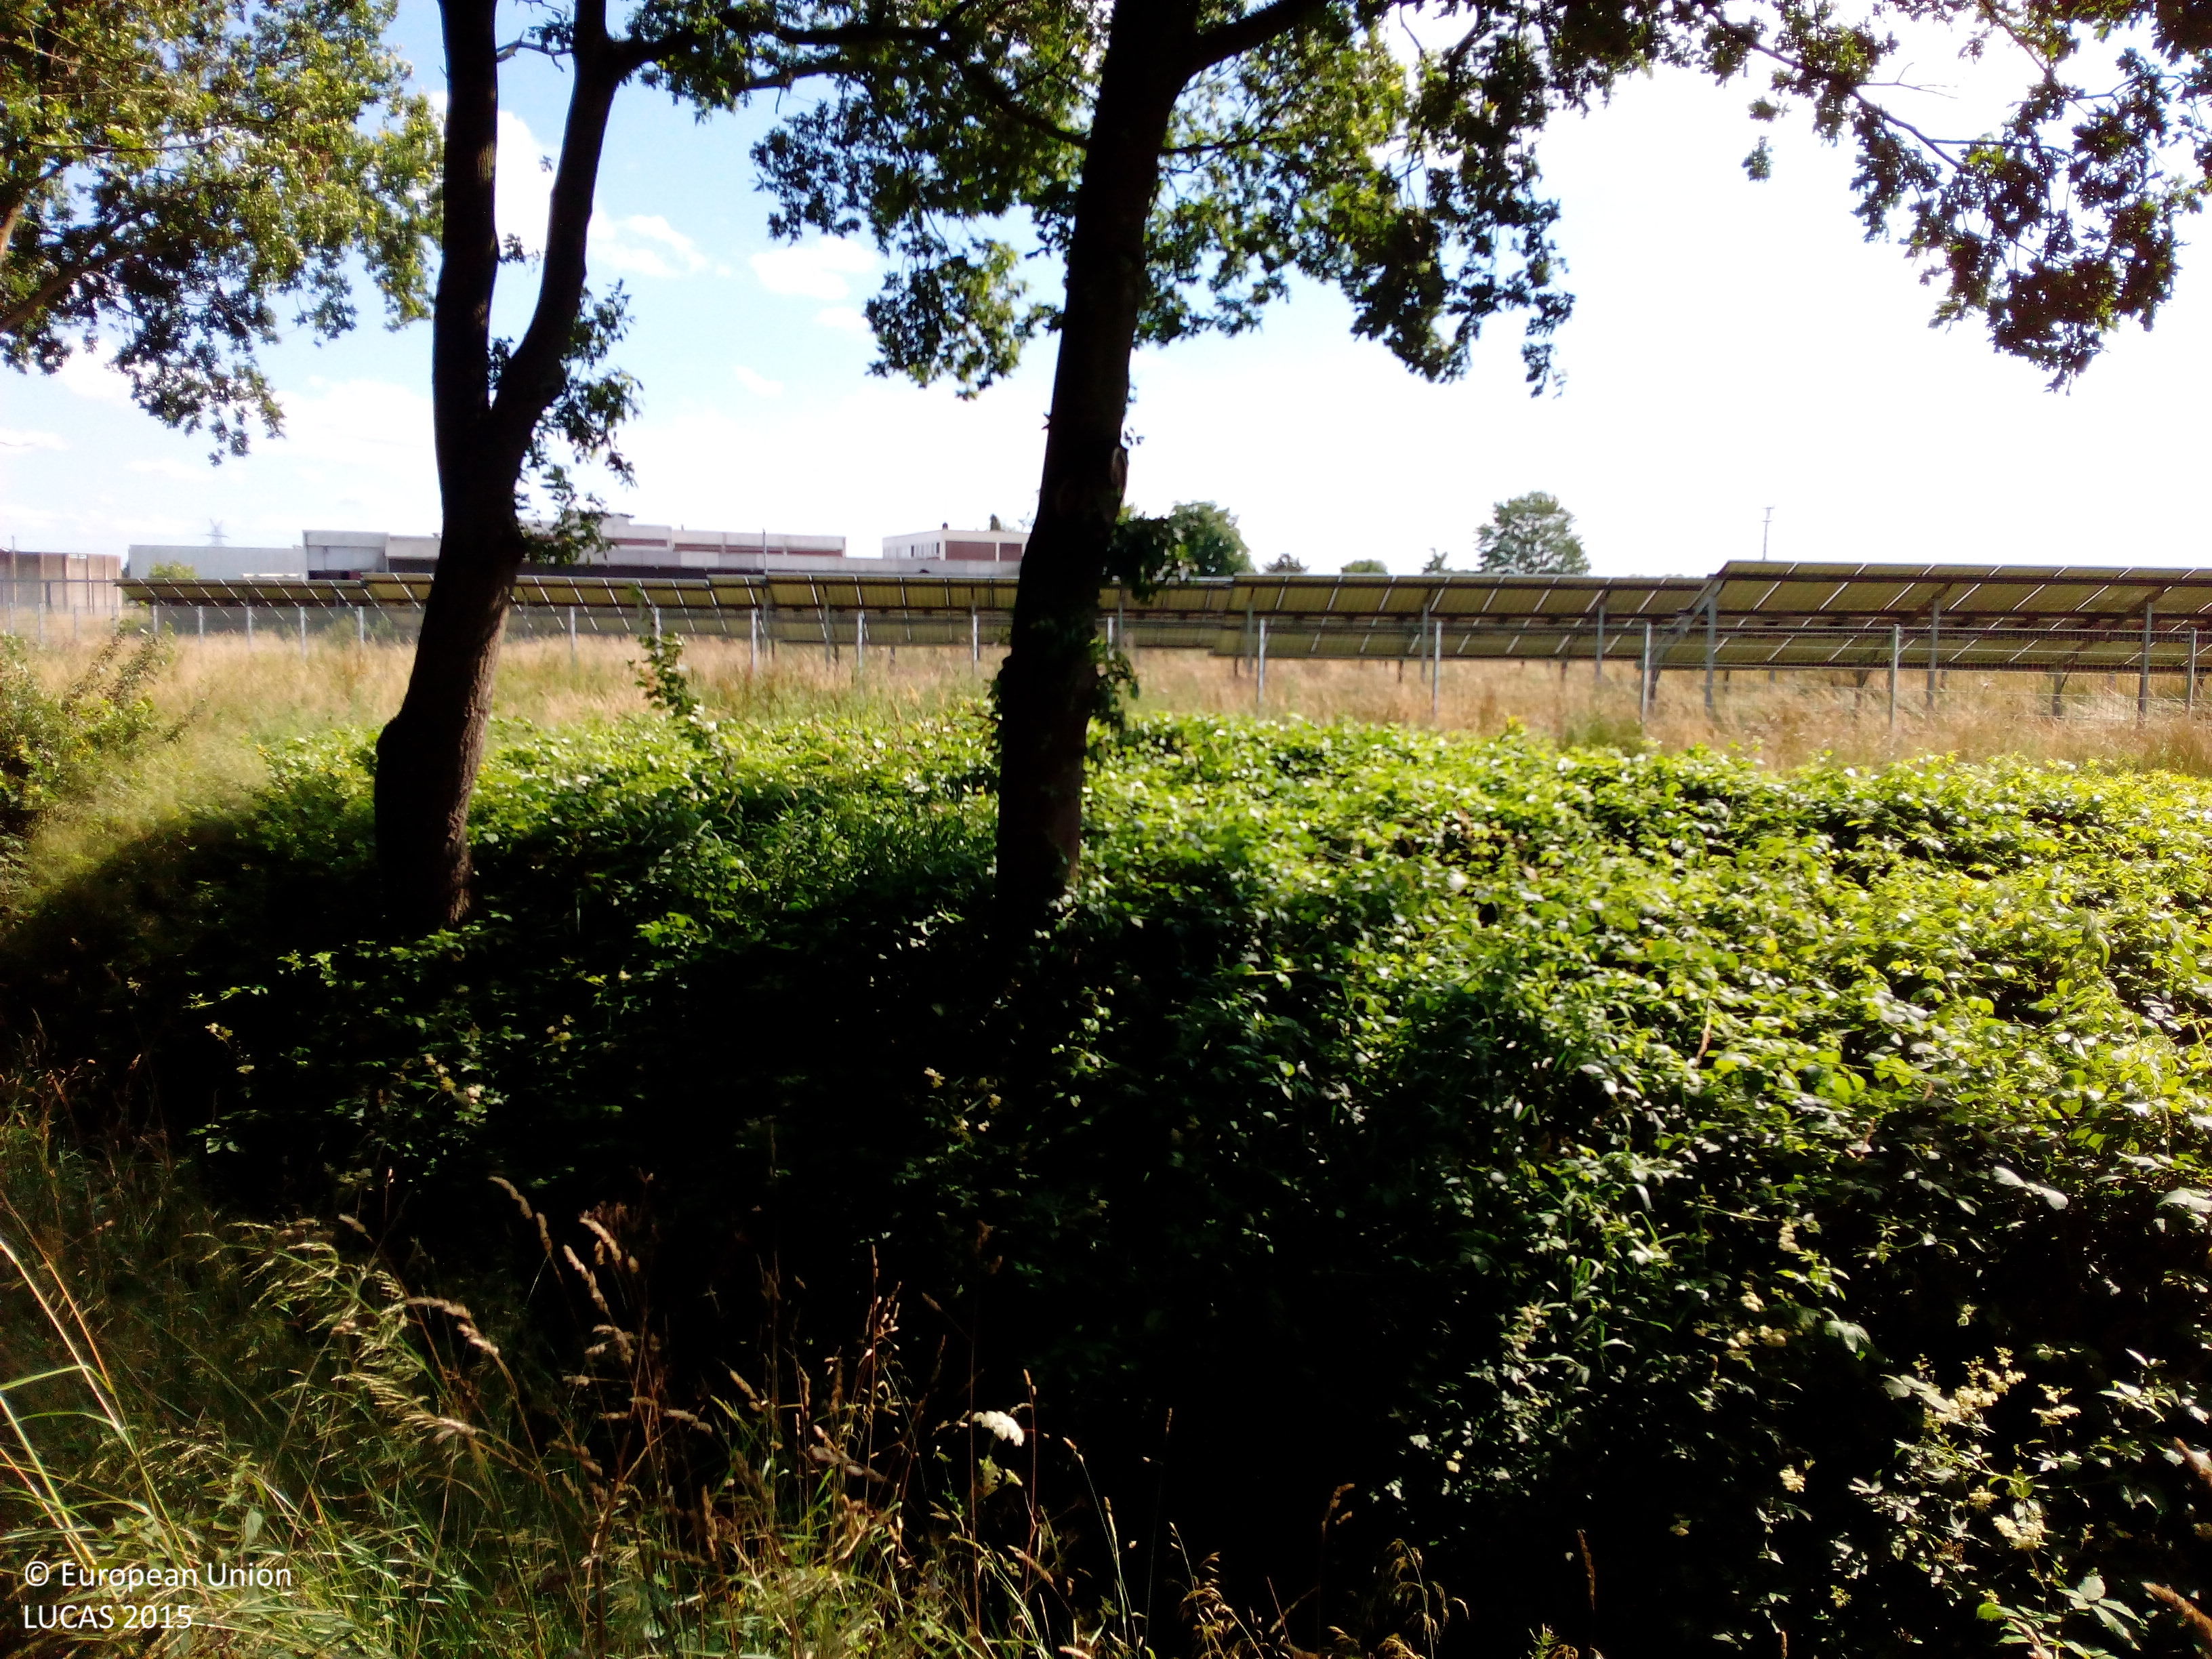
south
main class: Artificial land
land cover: Other artificial areas
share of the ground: > 75 %
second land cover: Grassland without tree/shrub cover
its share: > 75 %
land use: Energy production
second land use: Agriculture (excluding fallow land and kitchen gardens)
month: July
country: DE
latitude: 53.1155
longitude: 7.9836
